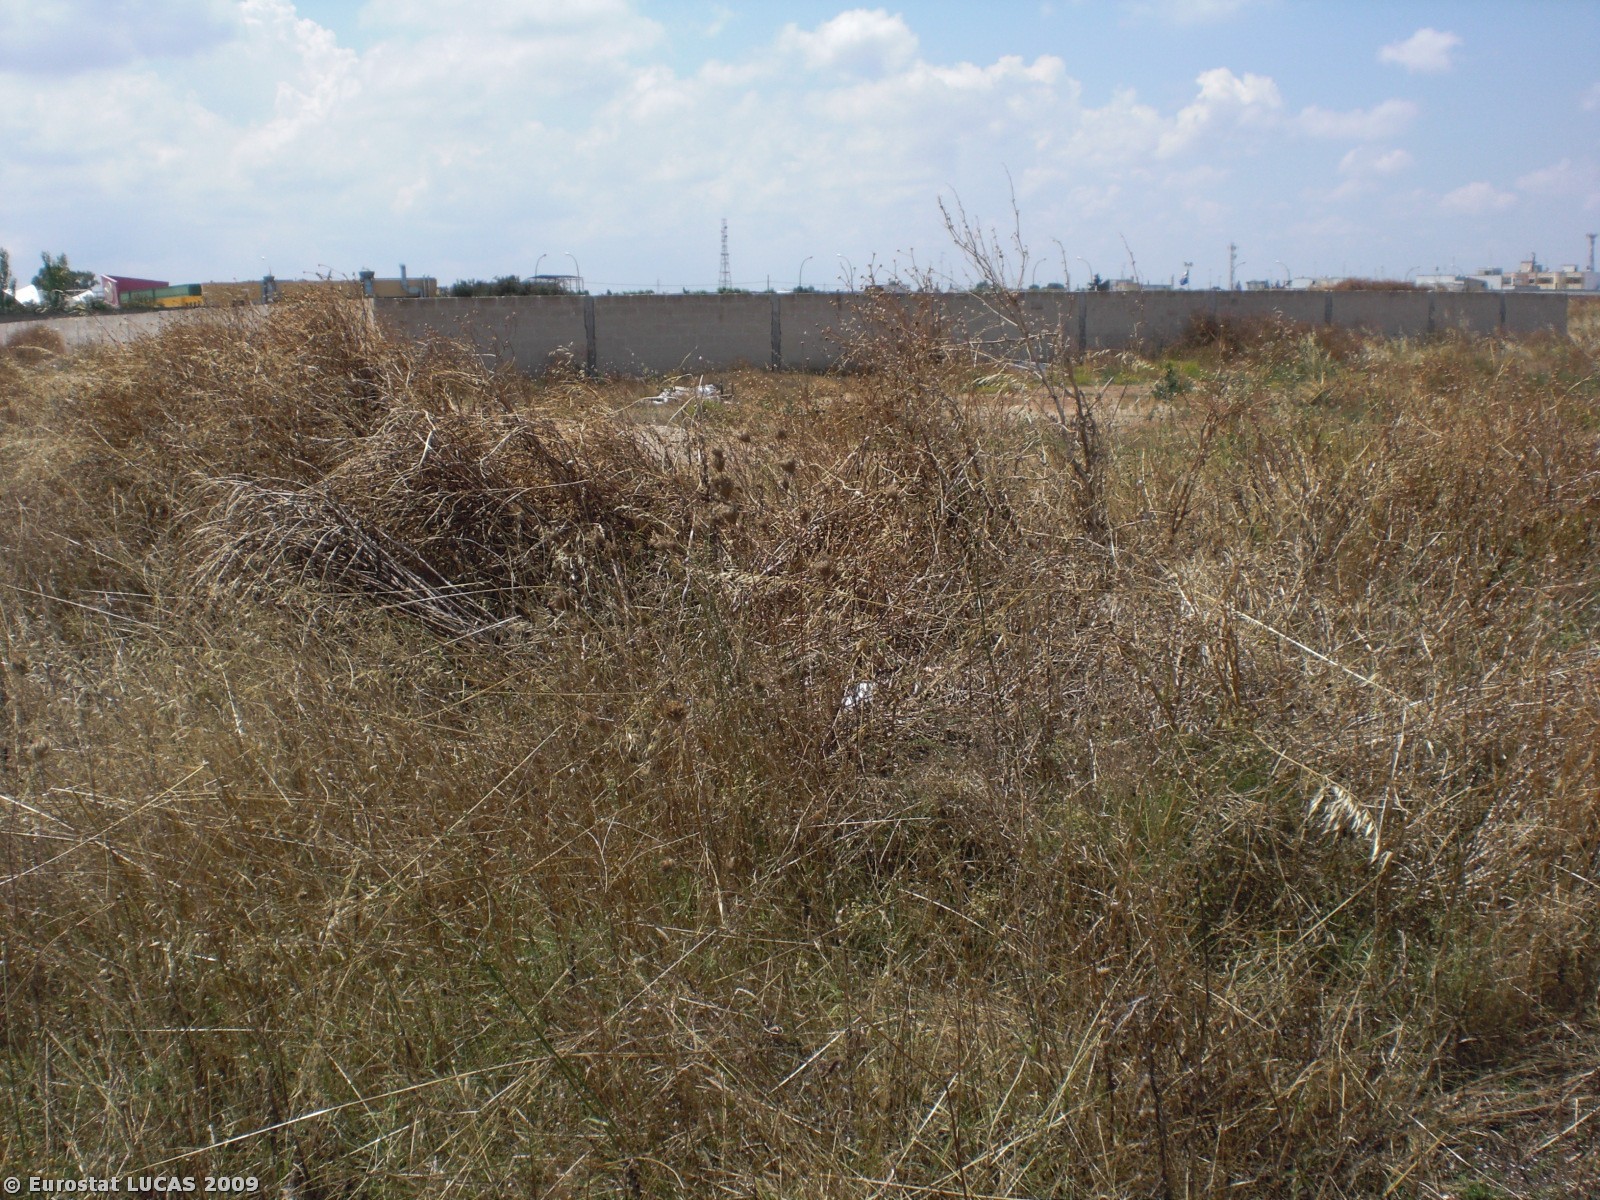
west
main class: Grassland
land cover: Spontaneously vegetated surfaces
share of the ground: > 75 %
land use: Fallow land
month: June
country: IT
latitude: 40.3832
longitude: 18.1386
